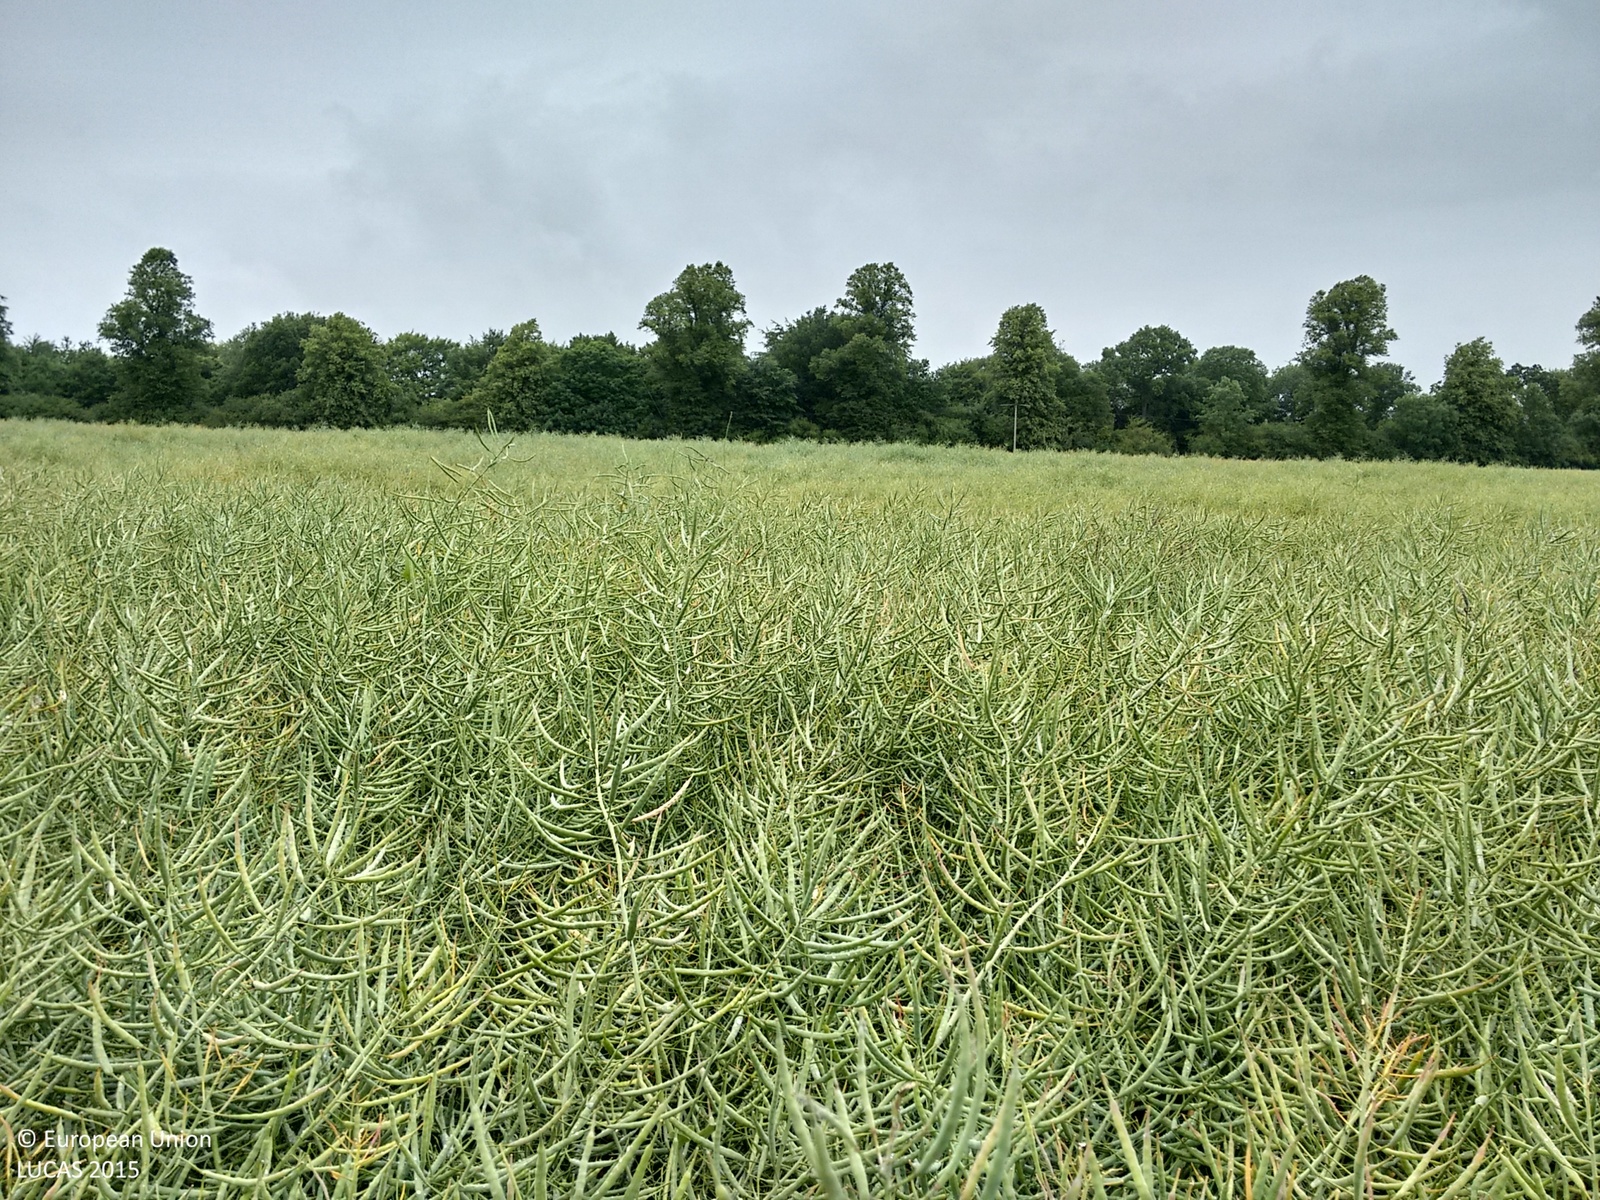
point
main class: Cropland
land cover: Rape and turnip rape
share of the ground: > 75 %
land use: Agriculture (excluding fallow land and kitchen gardens)
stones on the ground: < 10 %
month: June
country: GB
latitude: 51.4900
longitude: -1.1215
